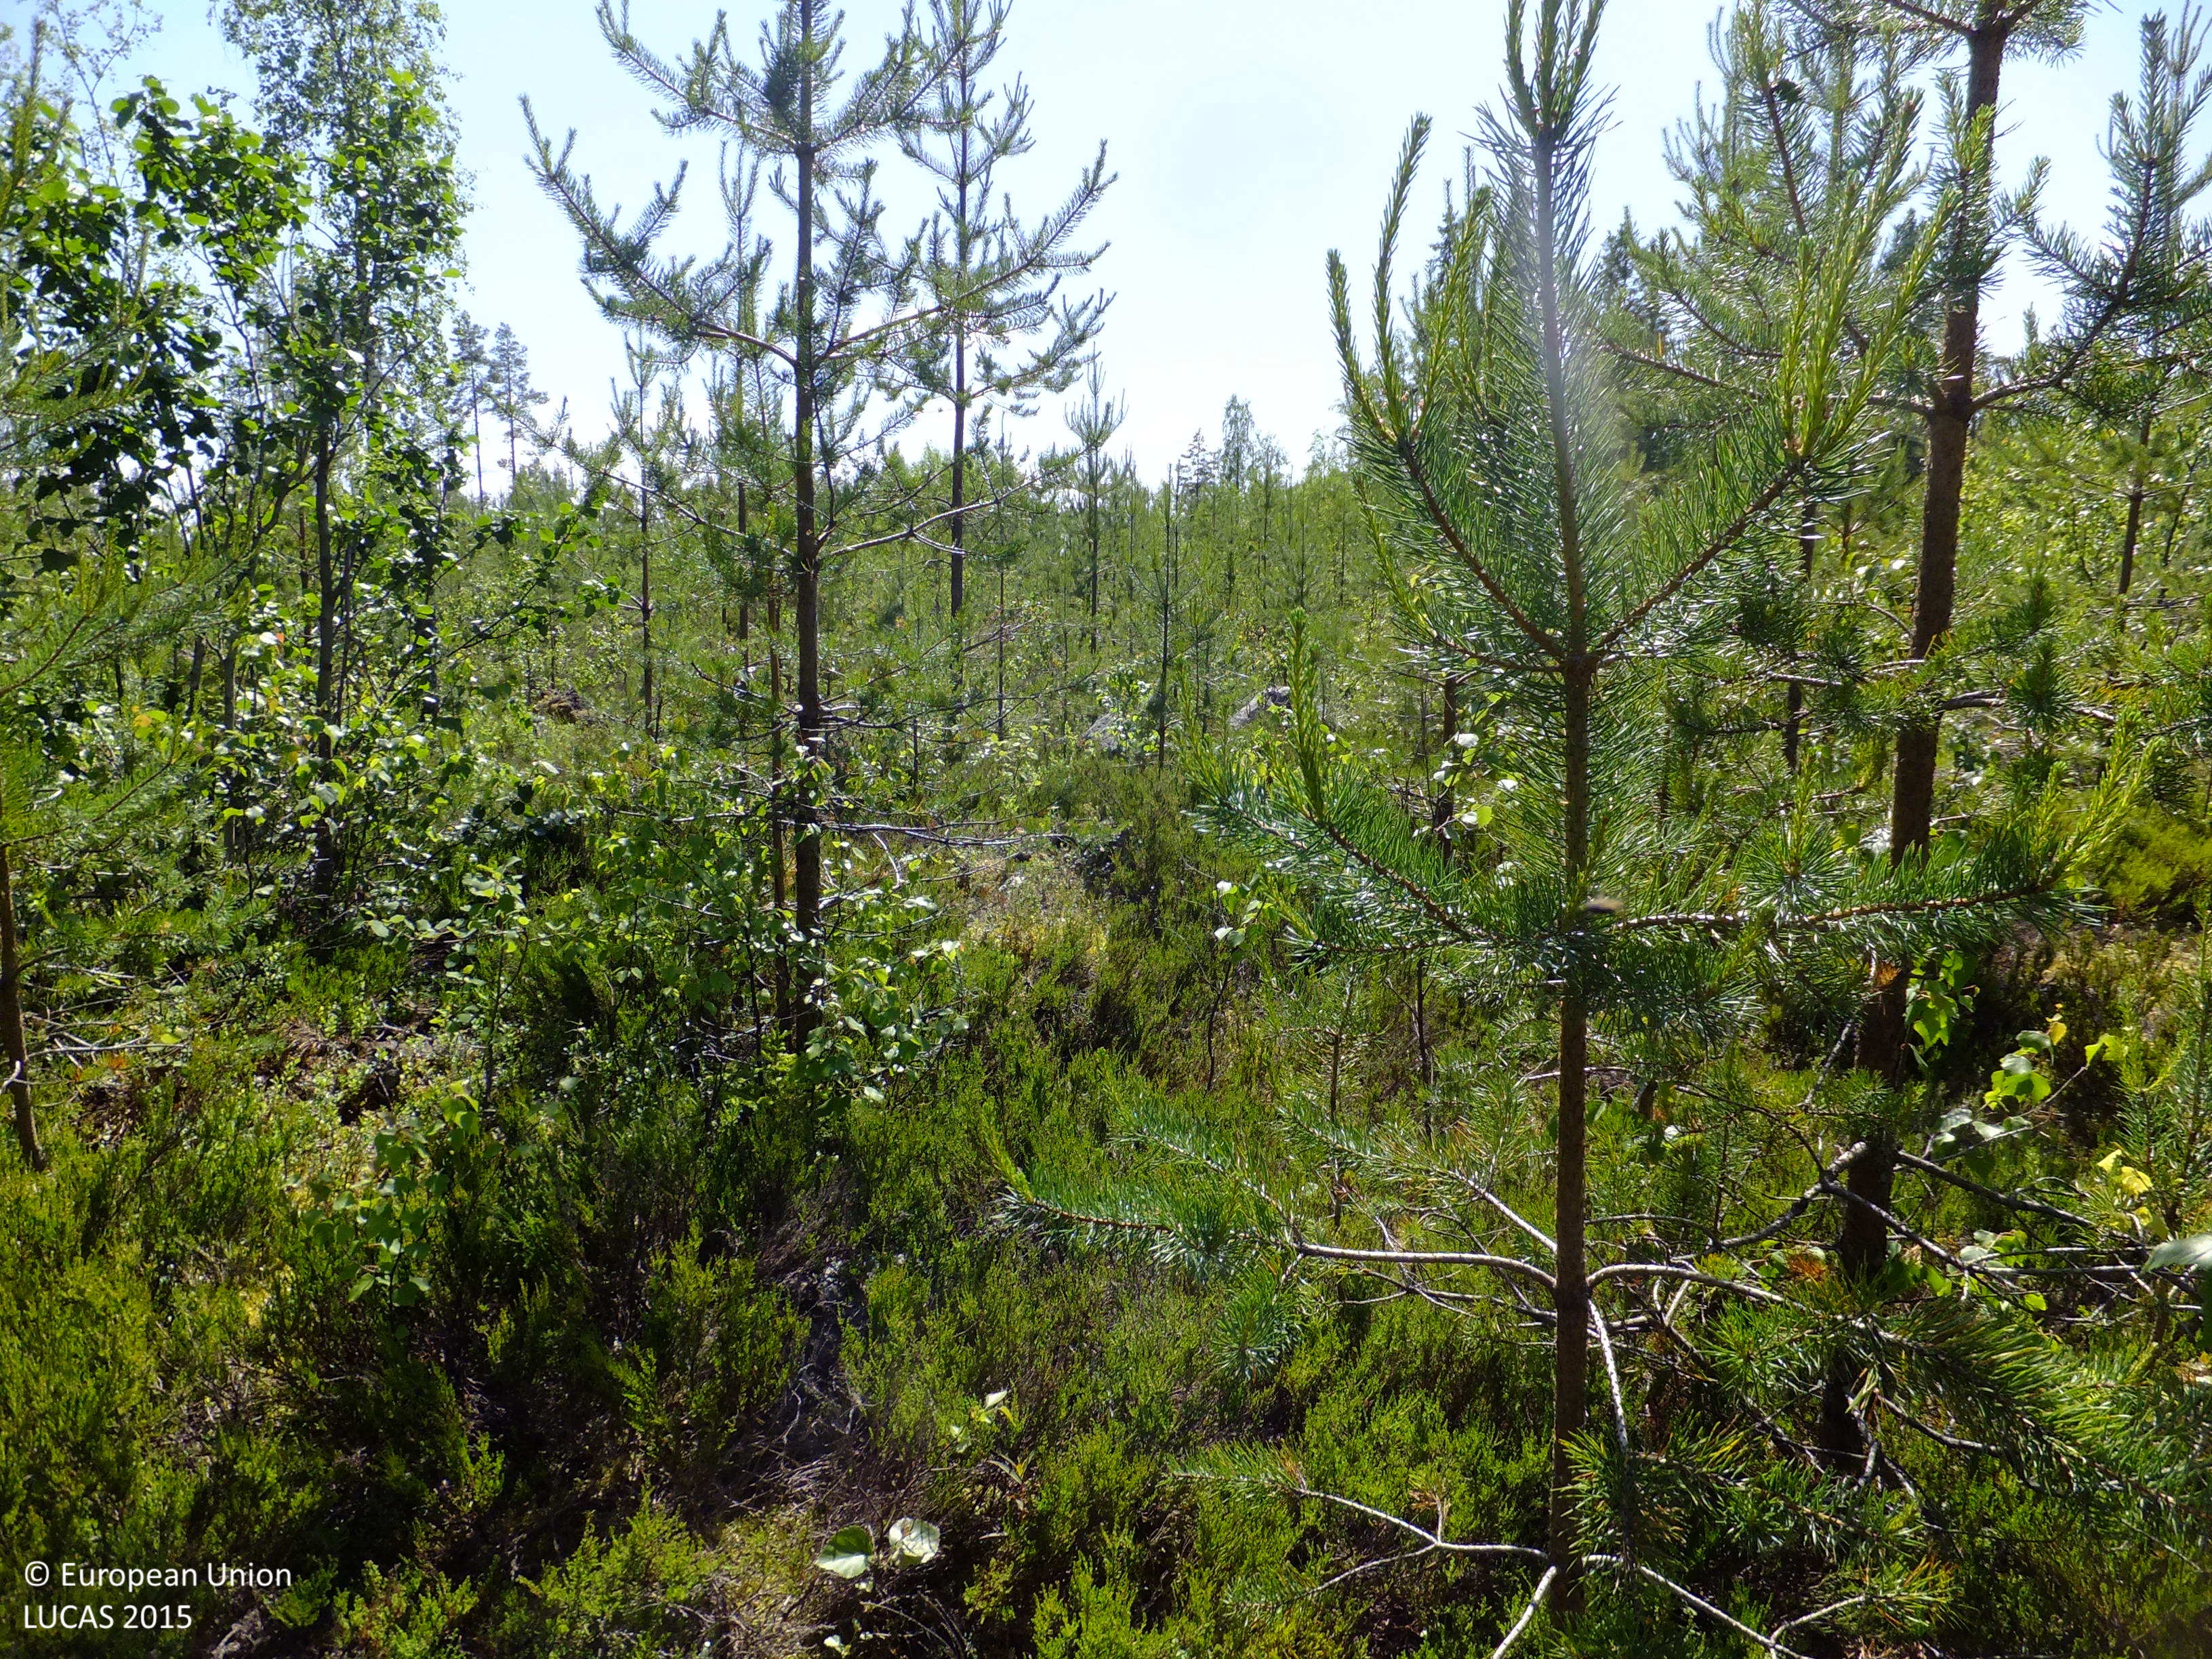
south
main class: Woodland
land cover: Pine dominated mixed woodland
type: boreal forest
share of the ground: 25 - 50 %
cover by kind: shrubs 40 %, coniferous forest trees 25 %, broadleaved forest trees 15 %, herbaceous plants 10 %, lichens and mosses 10 %
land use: Forestry
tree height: < 5 m
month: July
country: FI
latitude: 63.2744
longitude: 24.6141
